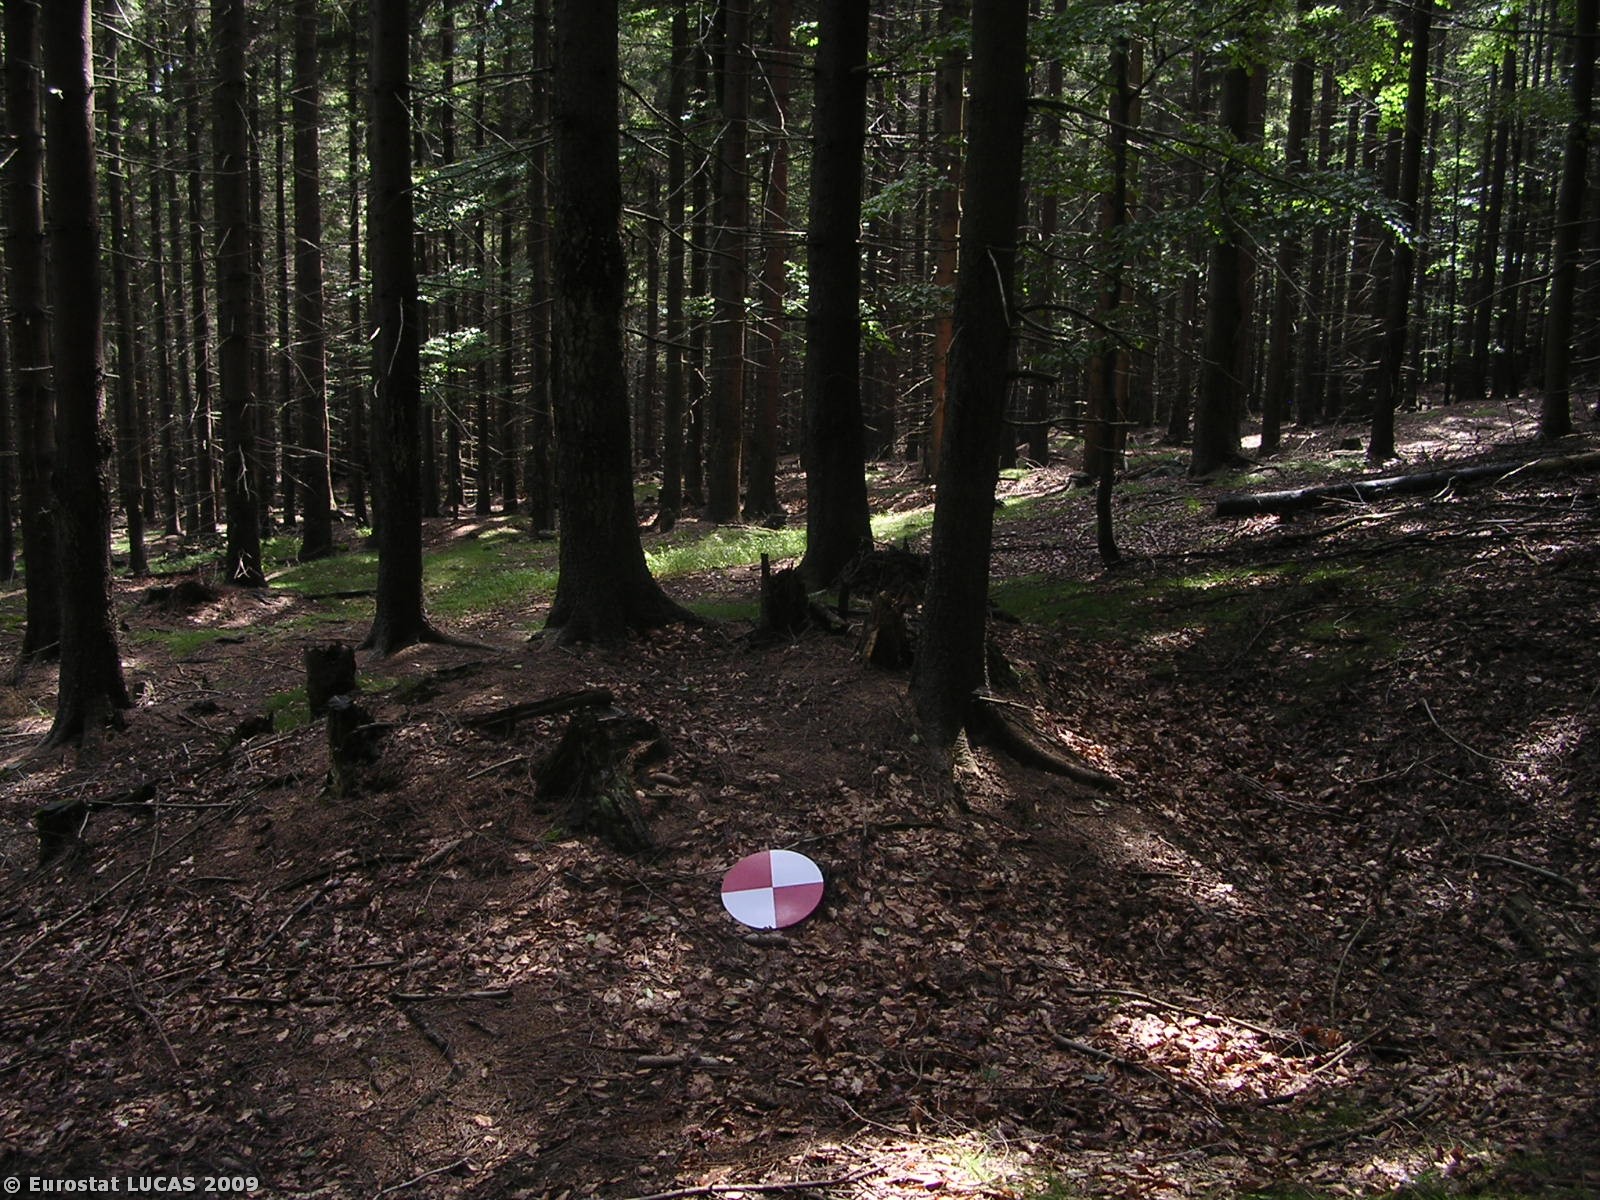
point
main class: Woodland
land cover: Mixed woodland
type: hemiboreal forest and nemoral coniferous forest and mixed broadleaved-coniferous forest
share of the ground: > 75 %
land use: Forestry
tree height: > 5 m
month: July
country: CZ
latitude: 50.8315
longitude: 14.5596
